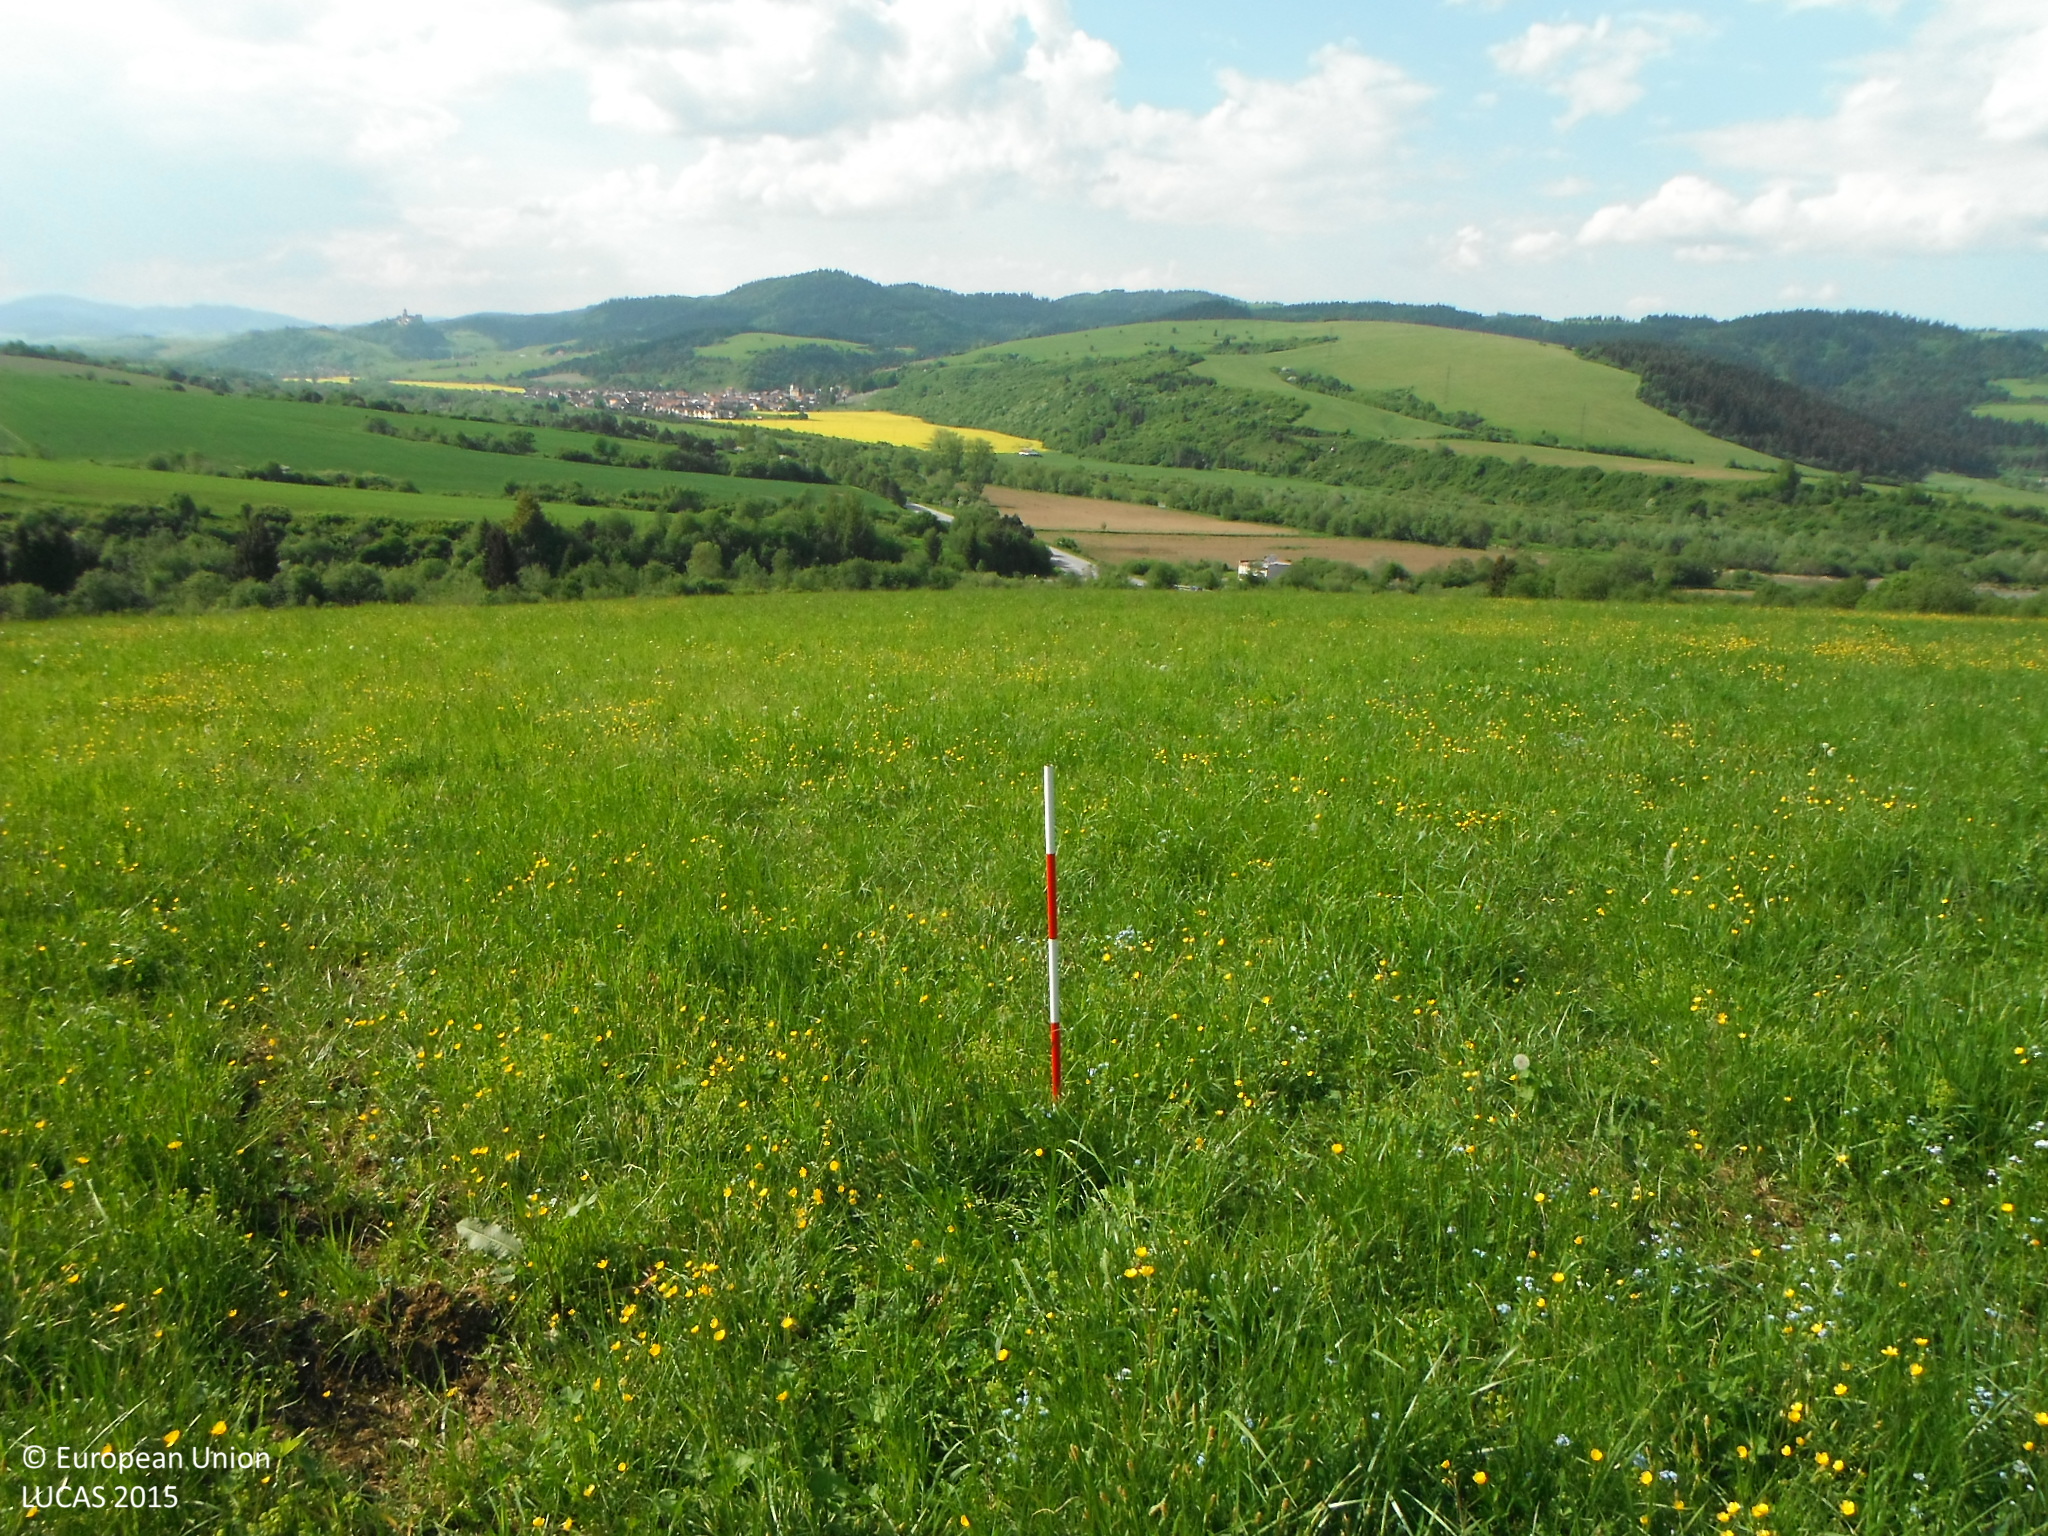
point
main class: Grassland
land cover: Grassland without tree/shrub cover
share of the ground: > 75 %
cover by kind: herbaceous plants 100 %
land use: Agriculture (excluding fallow land and kitchen gardens)
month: May
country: SK
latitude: 49.2755
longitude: 20.7468
